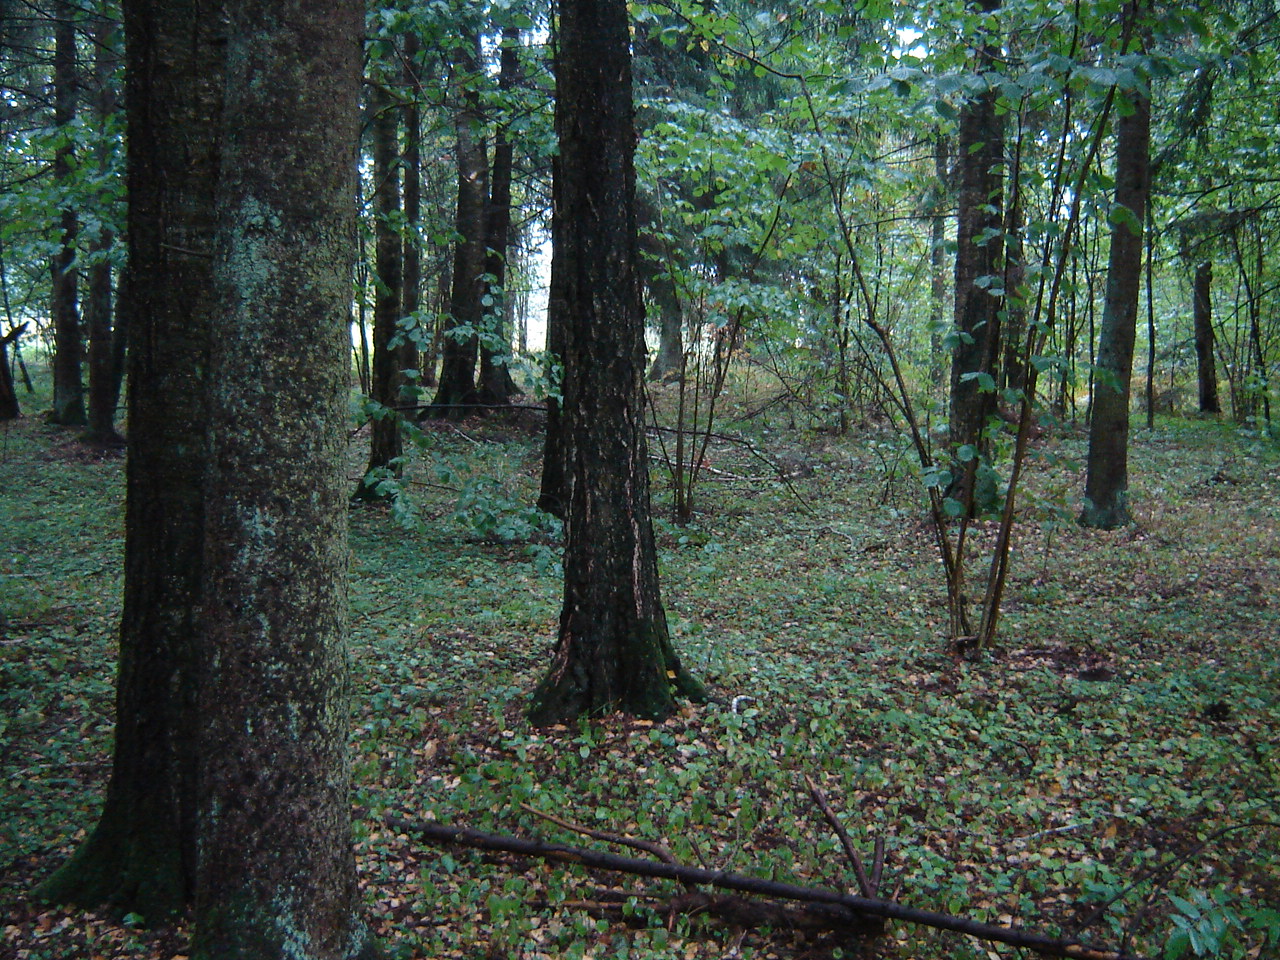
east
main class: Woodland
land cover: Spruce dominated mixed woodland
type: hemiboreal forest and nemoral coniferous forest and mixed broadleaved-coniferous forest
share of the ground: > 75 %
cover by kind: coniferous forest trees 60 %, broadleaved forest trees 30 %, herbaceous plants 5 %, unconsolidated bare surface 5 %
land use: Forestry
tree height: > 5 m
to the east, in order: Spruce dominated mixed woodland; Fences; Grassland without tree/shrub cover; Fences; Grass margins; Tracks; Grass margins; Fences; Spontaneously vegetated surfaces; Grassland without tree/shrub cover; Fences; Ditches and canals; Grassland without tree/shrub cover
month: September
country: LT
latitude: 54.4448
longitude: 25.0905
